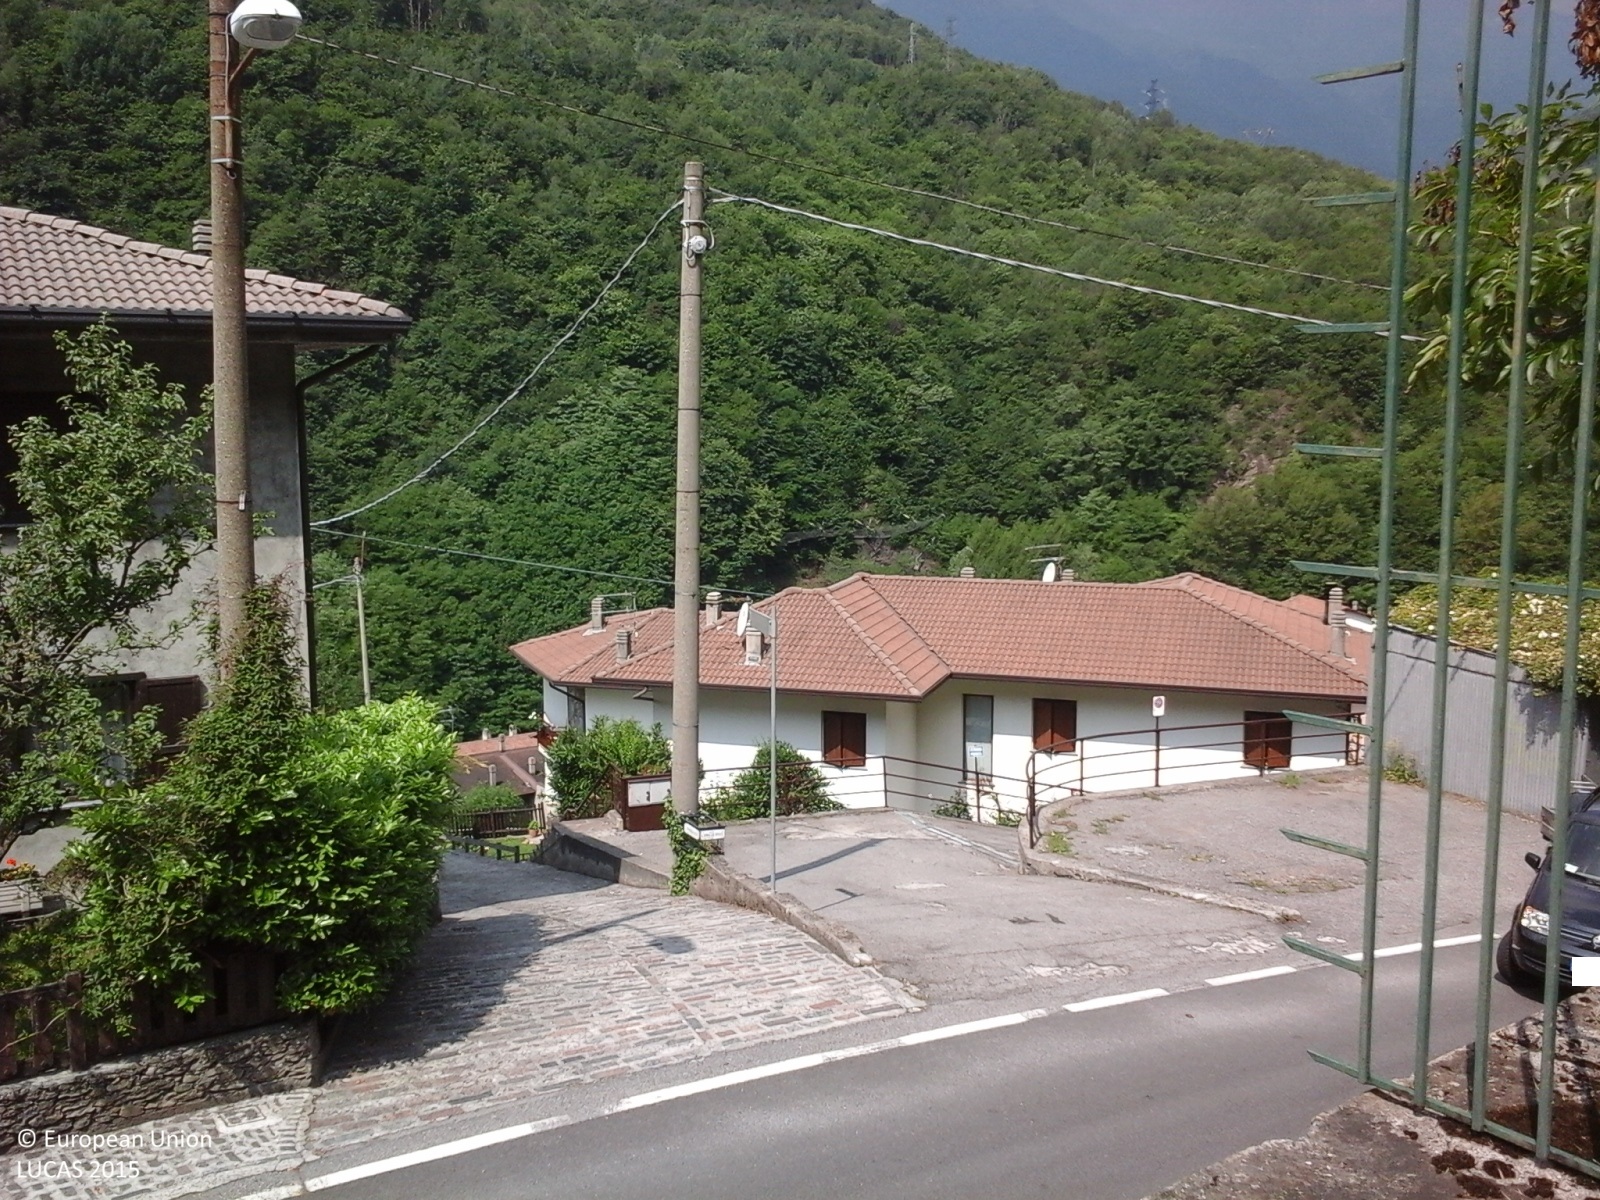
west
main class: Cropland
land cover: Tomatoes
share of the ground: 25 - 50 %
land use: Kitchen garden
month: June
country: IT
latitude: 46.0804
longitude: 10.3486
